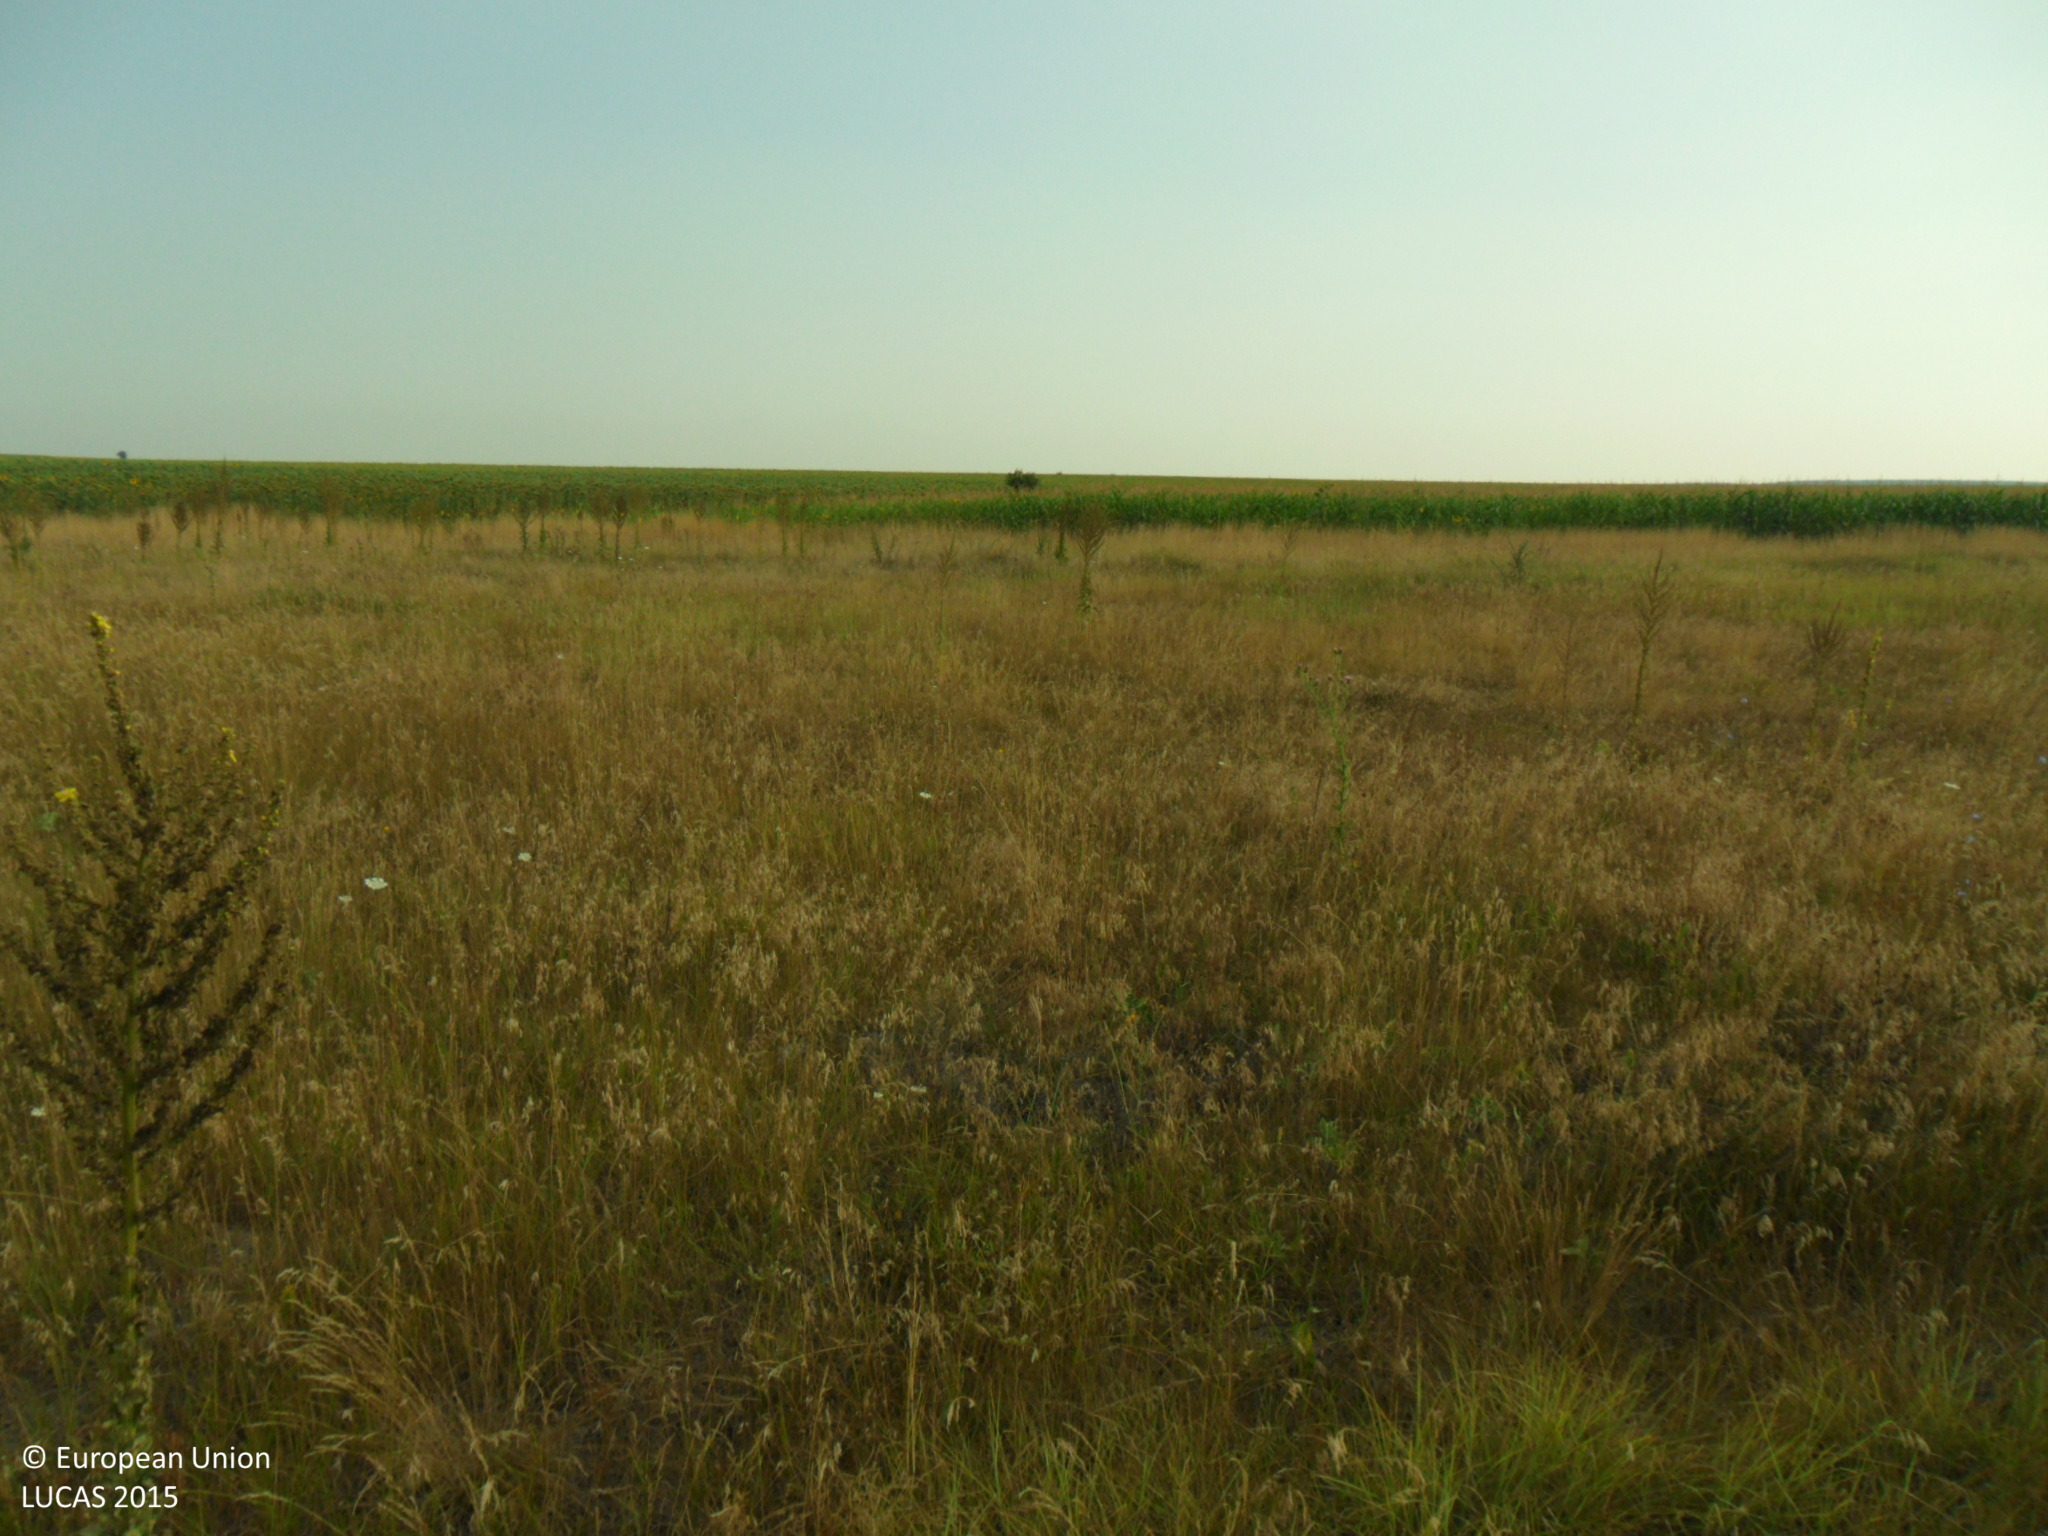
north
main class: Grassland
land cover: Spontaneously vegetated surfaces
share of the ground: > 75 %
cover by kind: herbaceous plants 100 %
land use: Fallow land
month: July
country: BG
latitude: 43.4180
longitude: 26.9745
